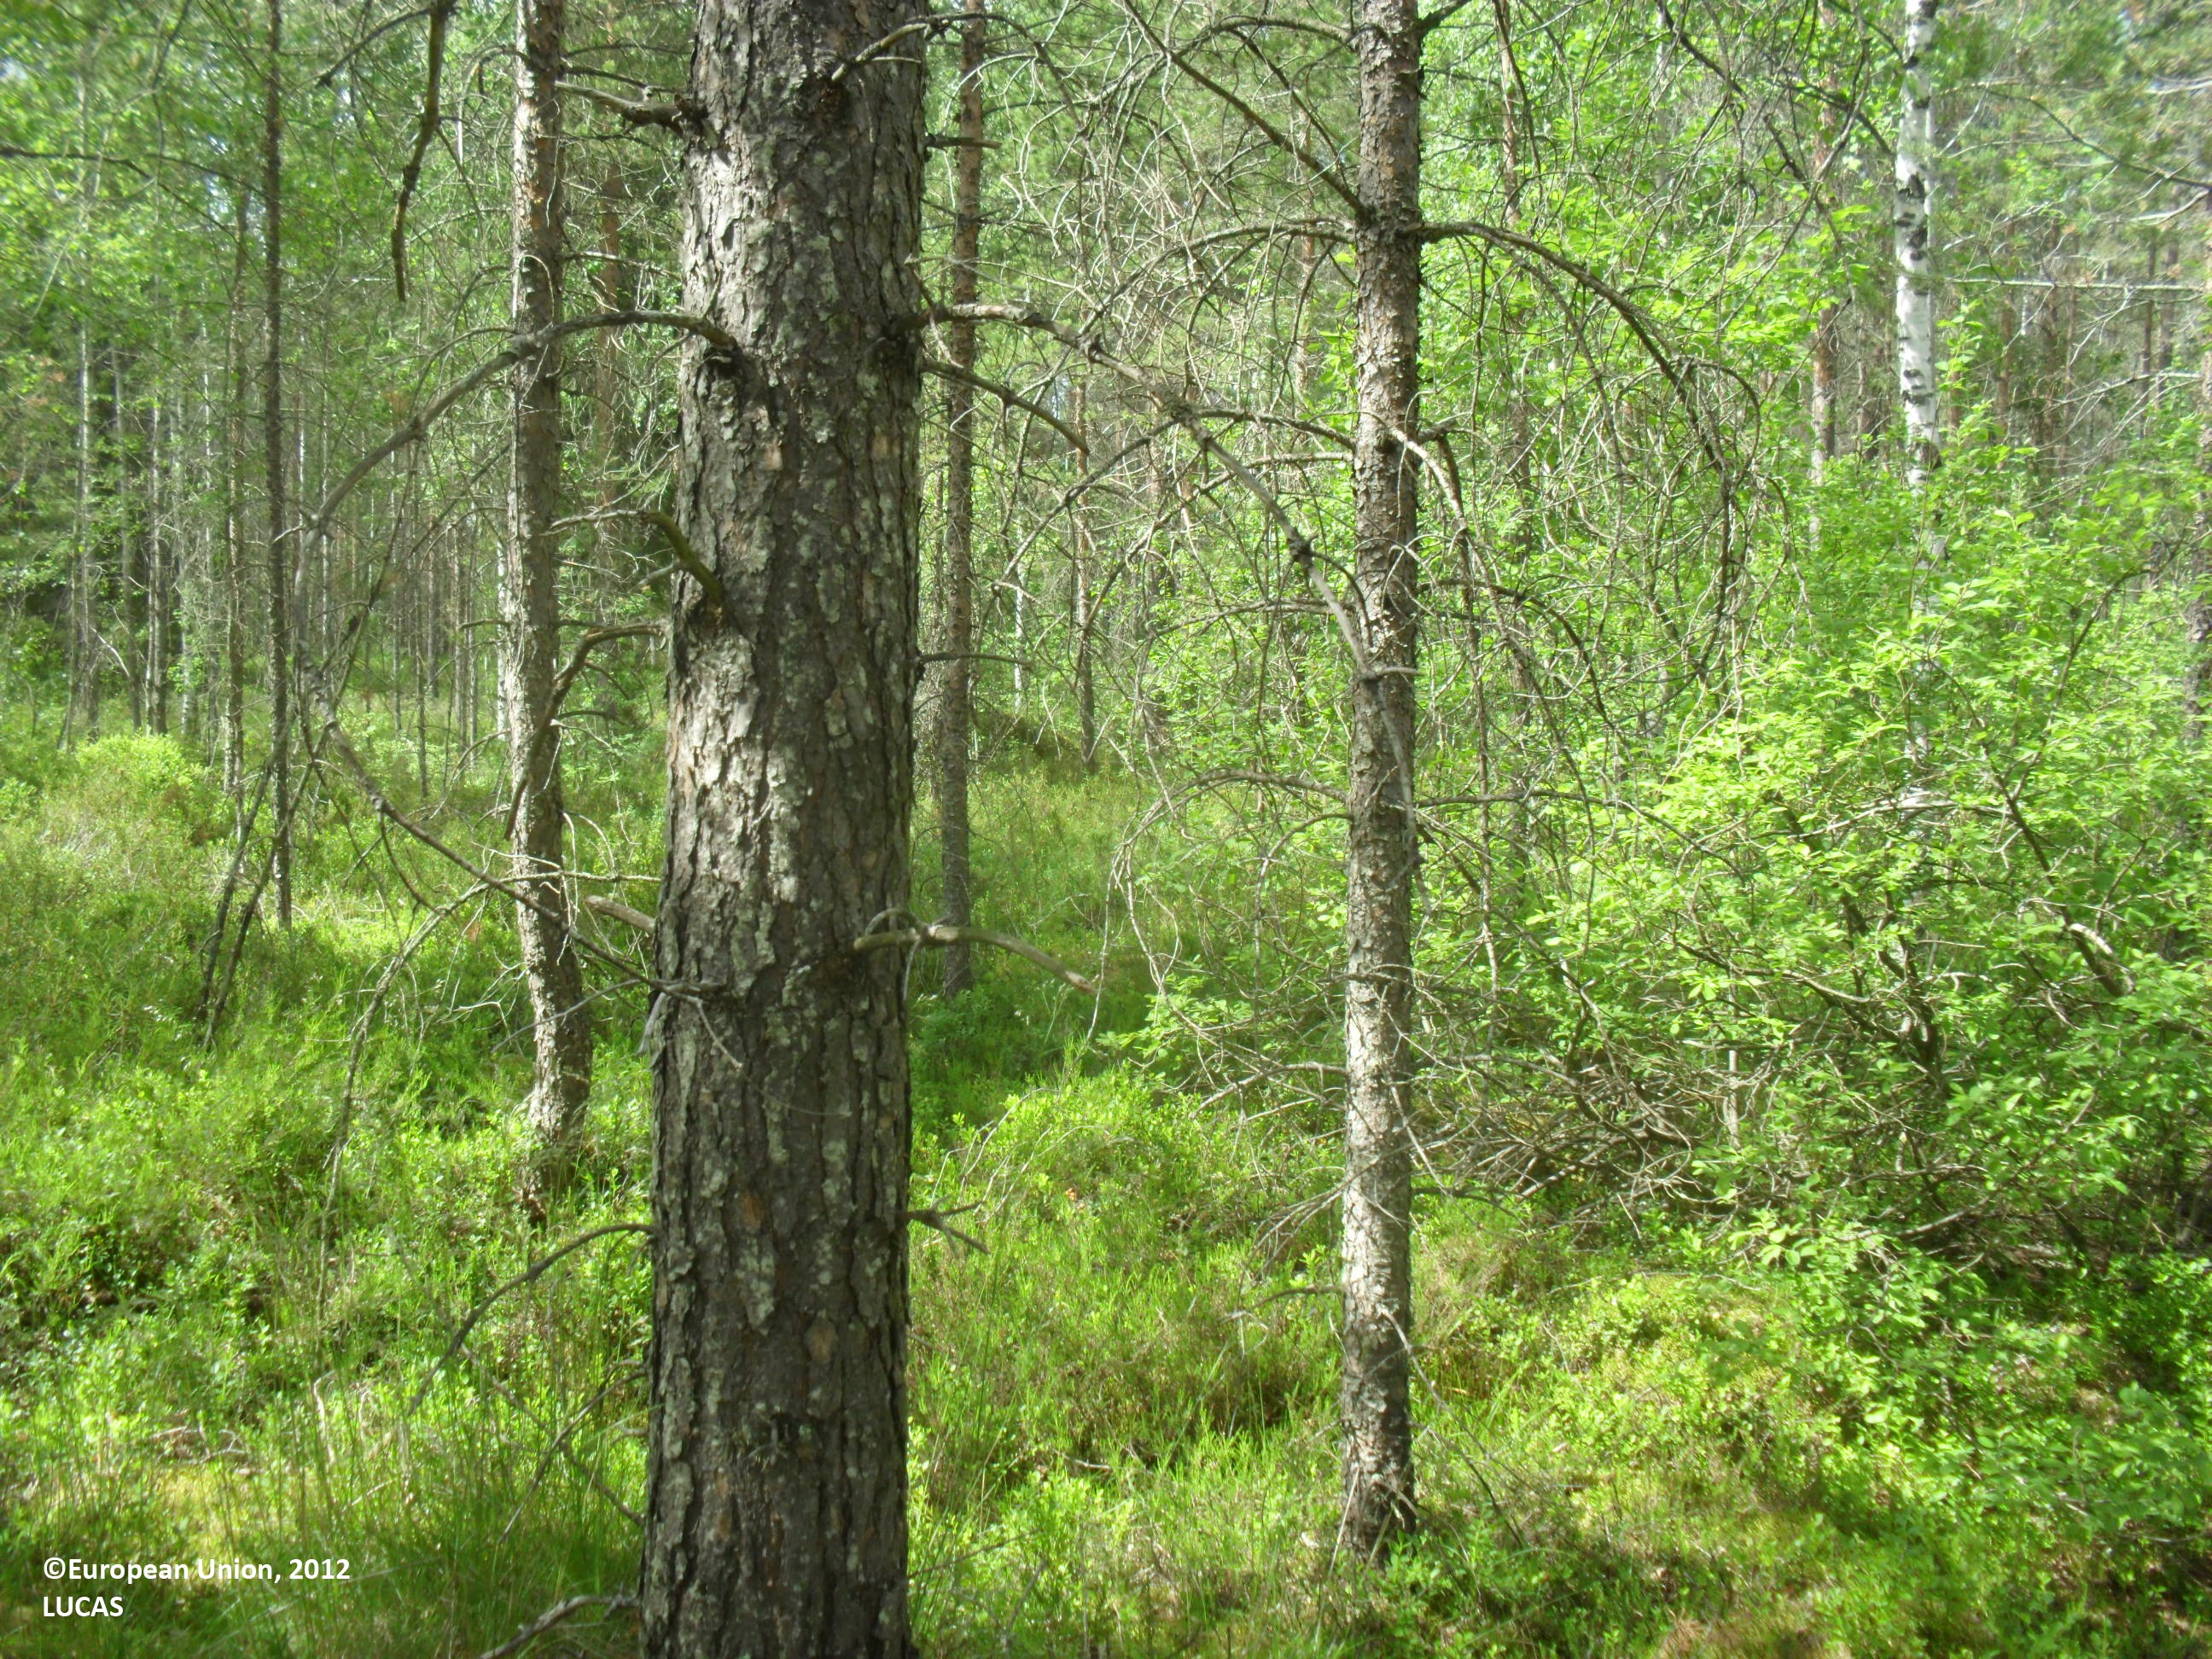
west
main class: Woodland
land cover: Other mixed woodland
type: boreal forest
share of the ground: 50 - 75 %
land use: Forestry
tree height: > 5 m
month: July
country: FI
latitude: 63.5797
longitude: 23.9069
